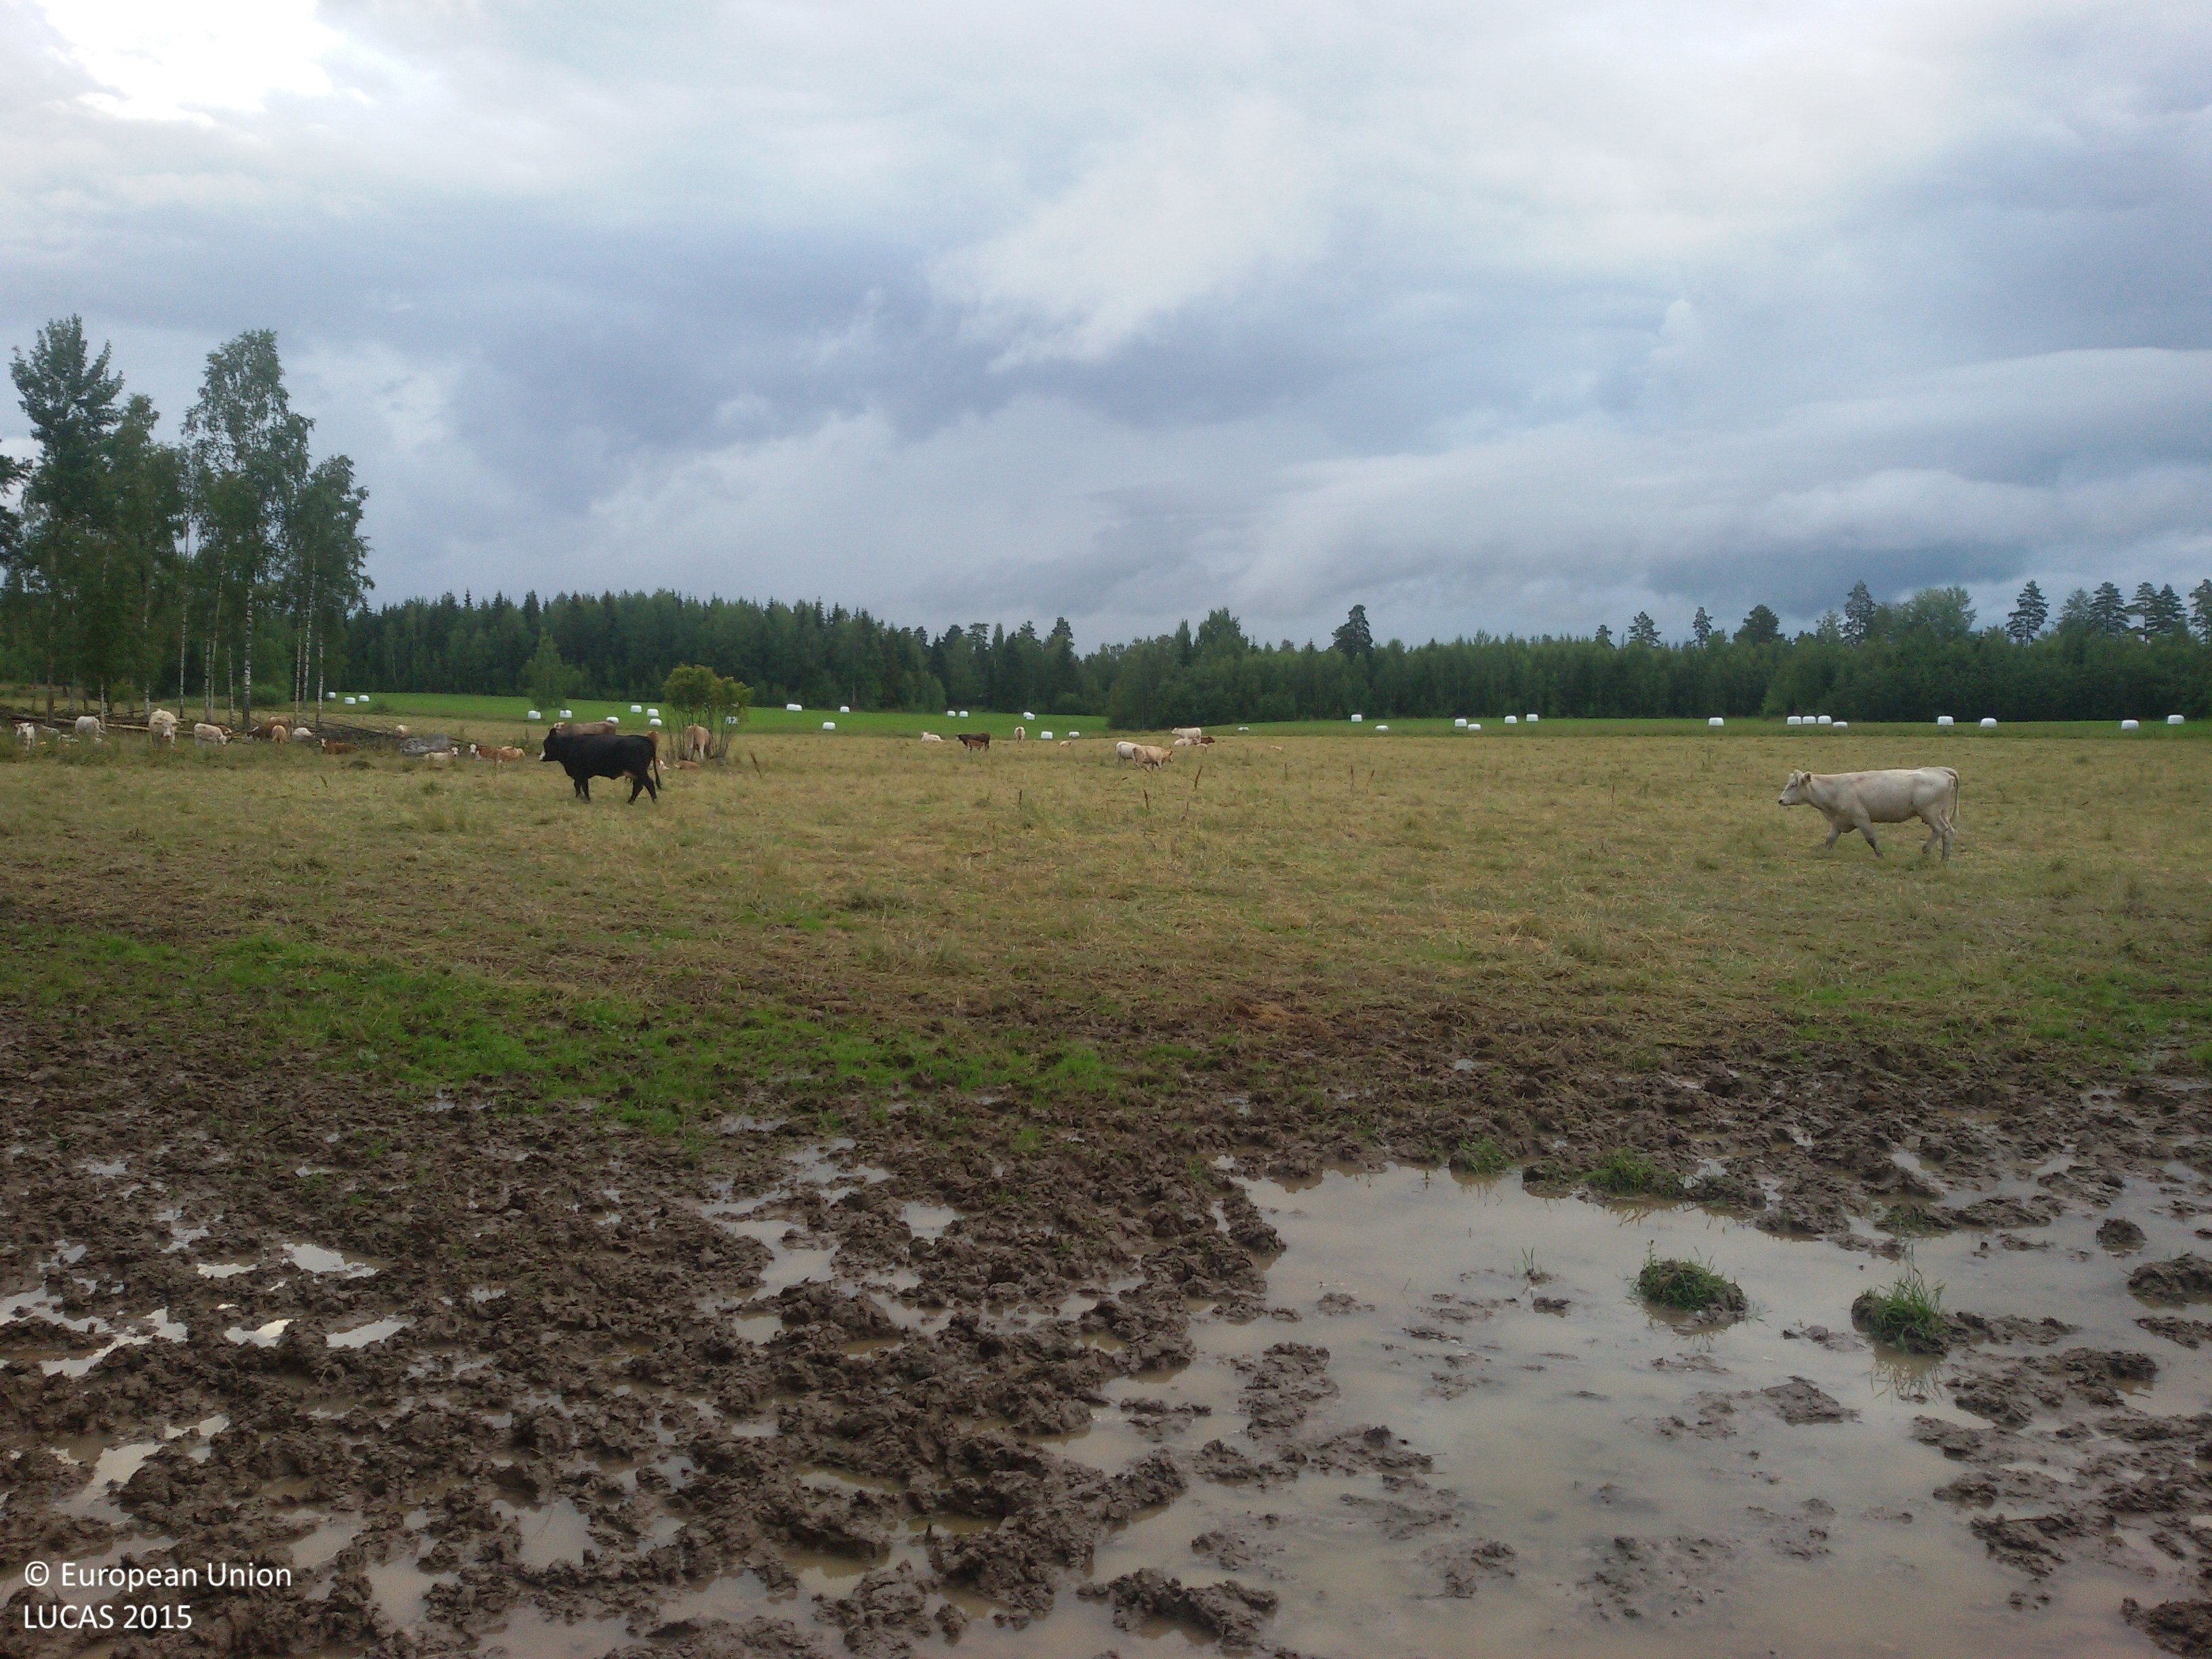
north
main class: Grassland
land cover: Grassland without tree/shrub cover
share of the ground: > 75 %
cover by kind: herbaceous plants 100 %
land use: Agriculture (excluding fallow land and kitchen gardens)
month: July
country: SE
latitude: 60.4994
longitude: 15.6860
